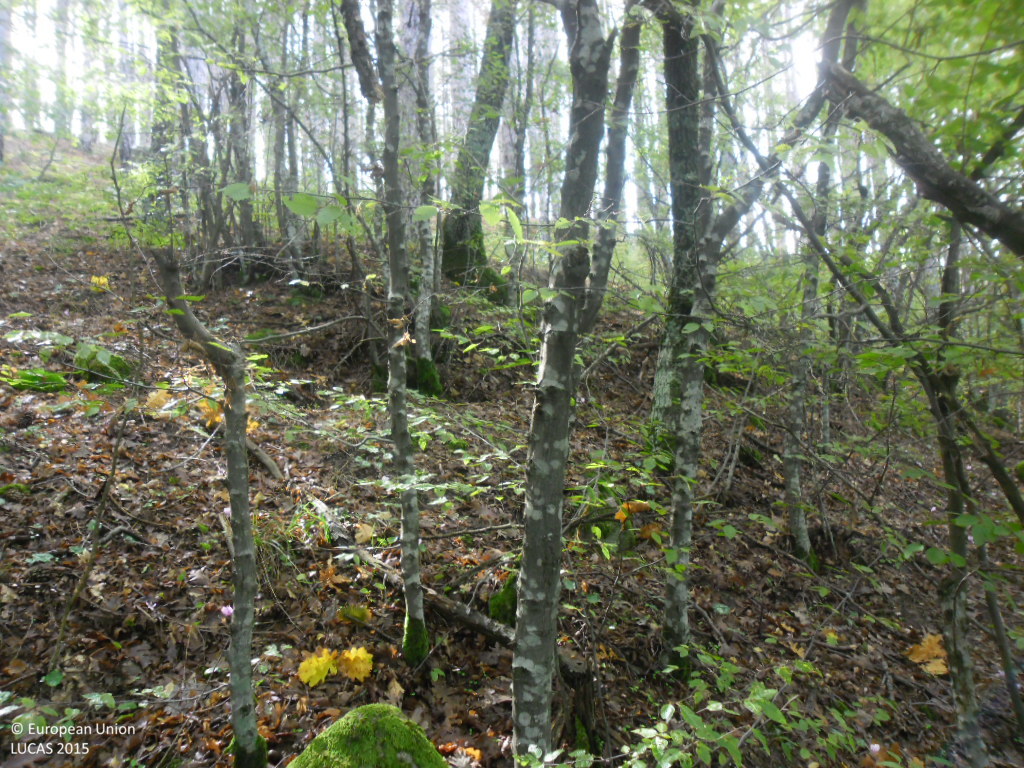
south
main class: Woodland
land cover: Pine dominated mixed woodland
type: hemiboreal forest and nemoral coniferous forest and mixed broadleaved-coniferous forest
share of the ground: > 75 %
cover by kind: coniferous forest trees 75 %, broadleaved forest trees 25 %
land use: Forestry
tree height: > 5 m
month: October
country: BG
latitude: 41.7442
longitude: 23.2385
